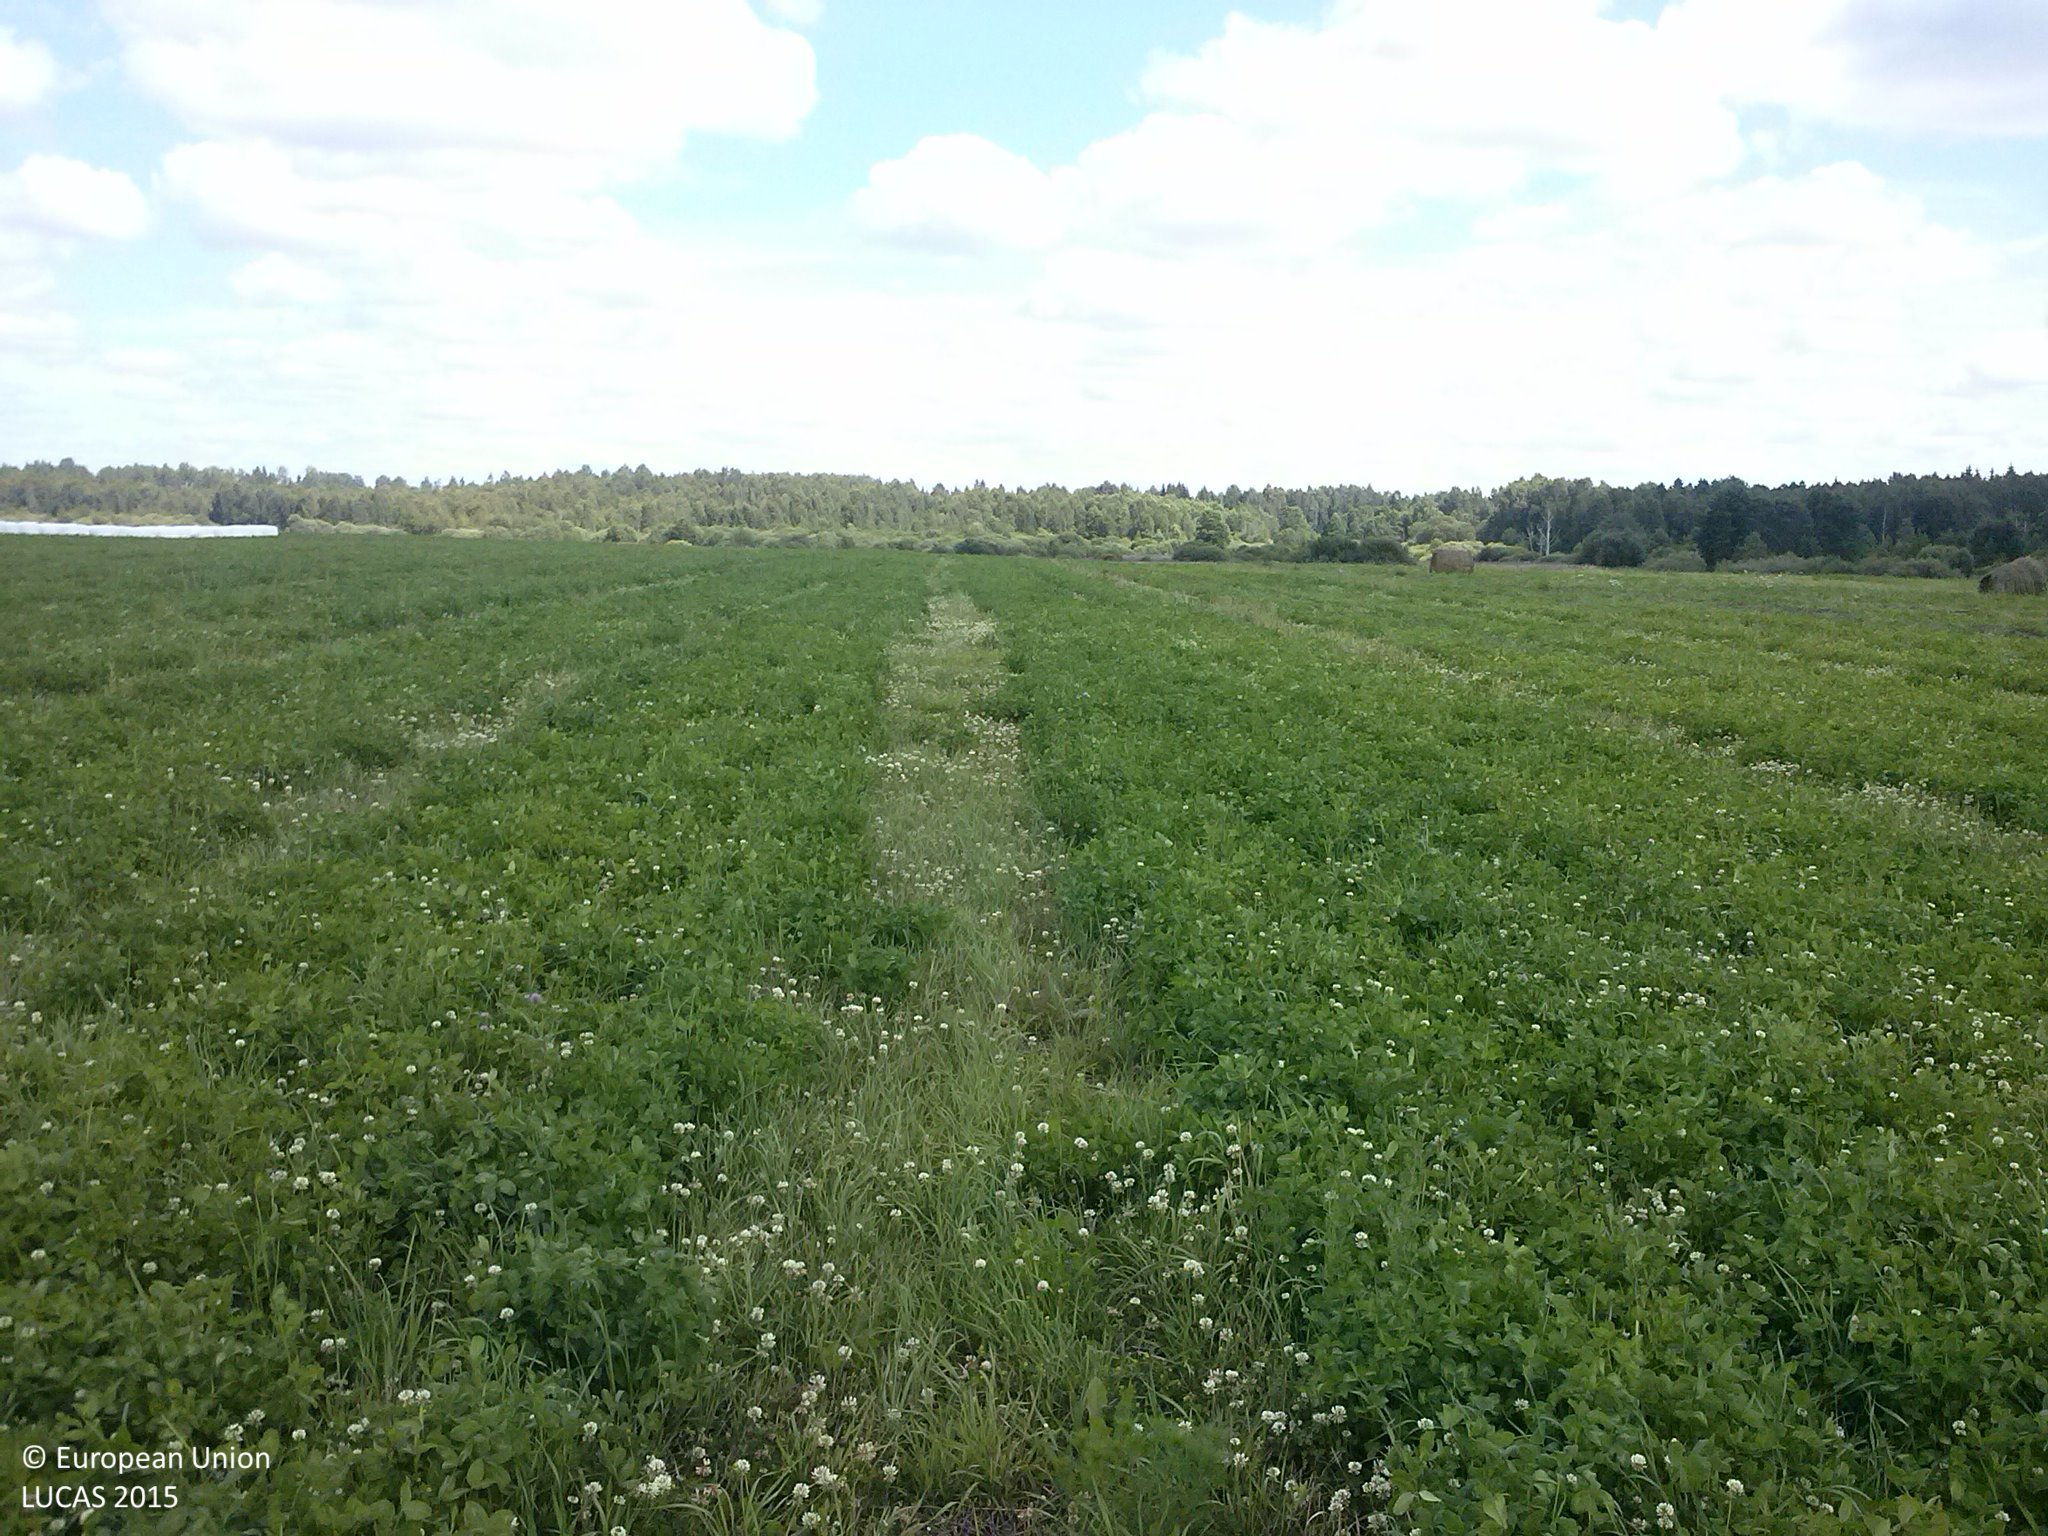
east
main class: Grassland
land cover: Grassland without tree/shrub cover
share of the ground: > 75 %
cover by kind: herbaceous plants 100 %
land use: Agriculture (excluding fallow land and kitchen gardens)
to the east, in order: Grassland without tree/shrub cover; Spontaneously vegetated surfaces
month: July
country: LV
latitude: 56.5129
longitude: 27.0157
